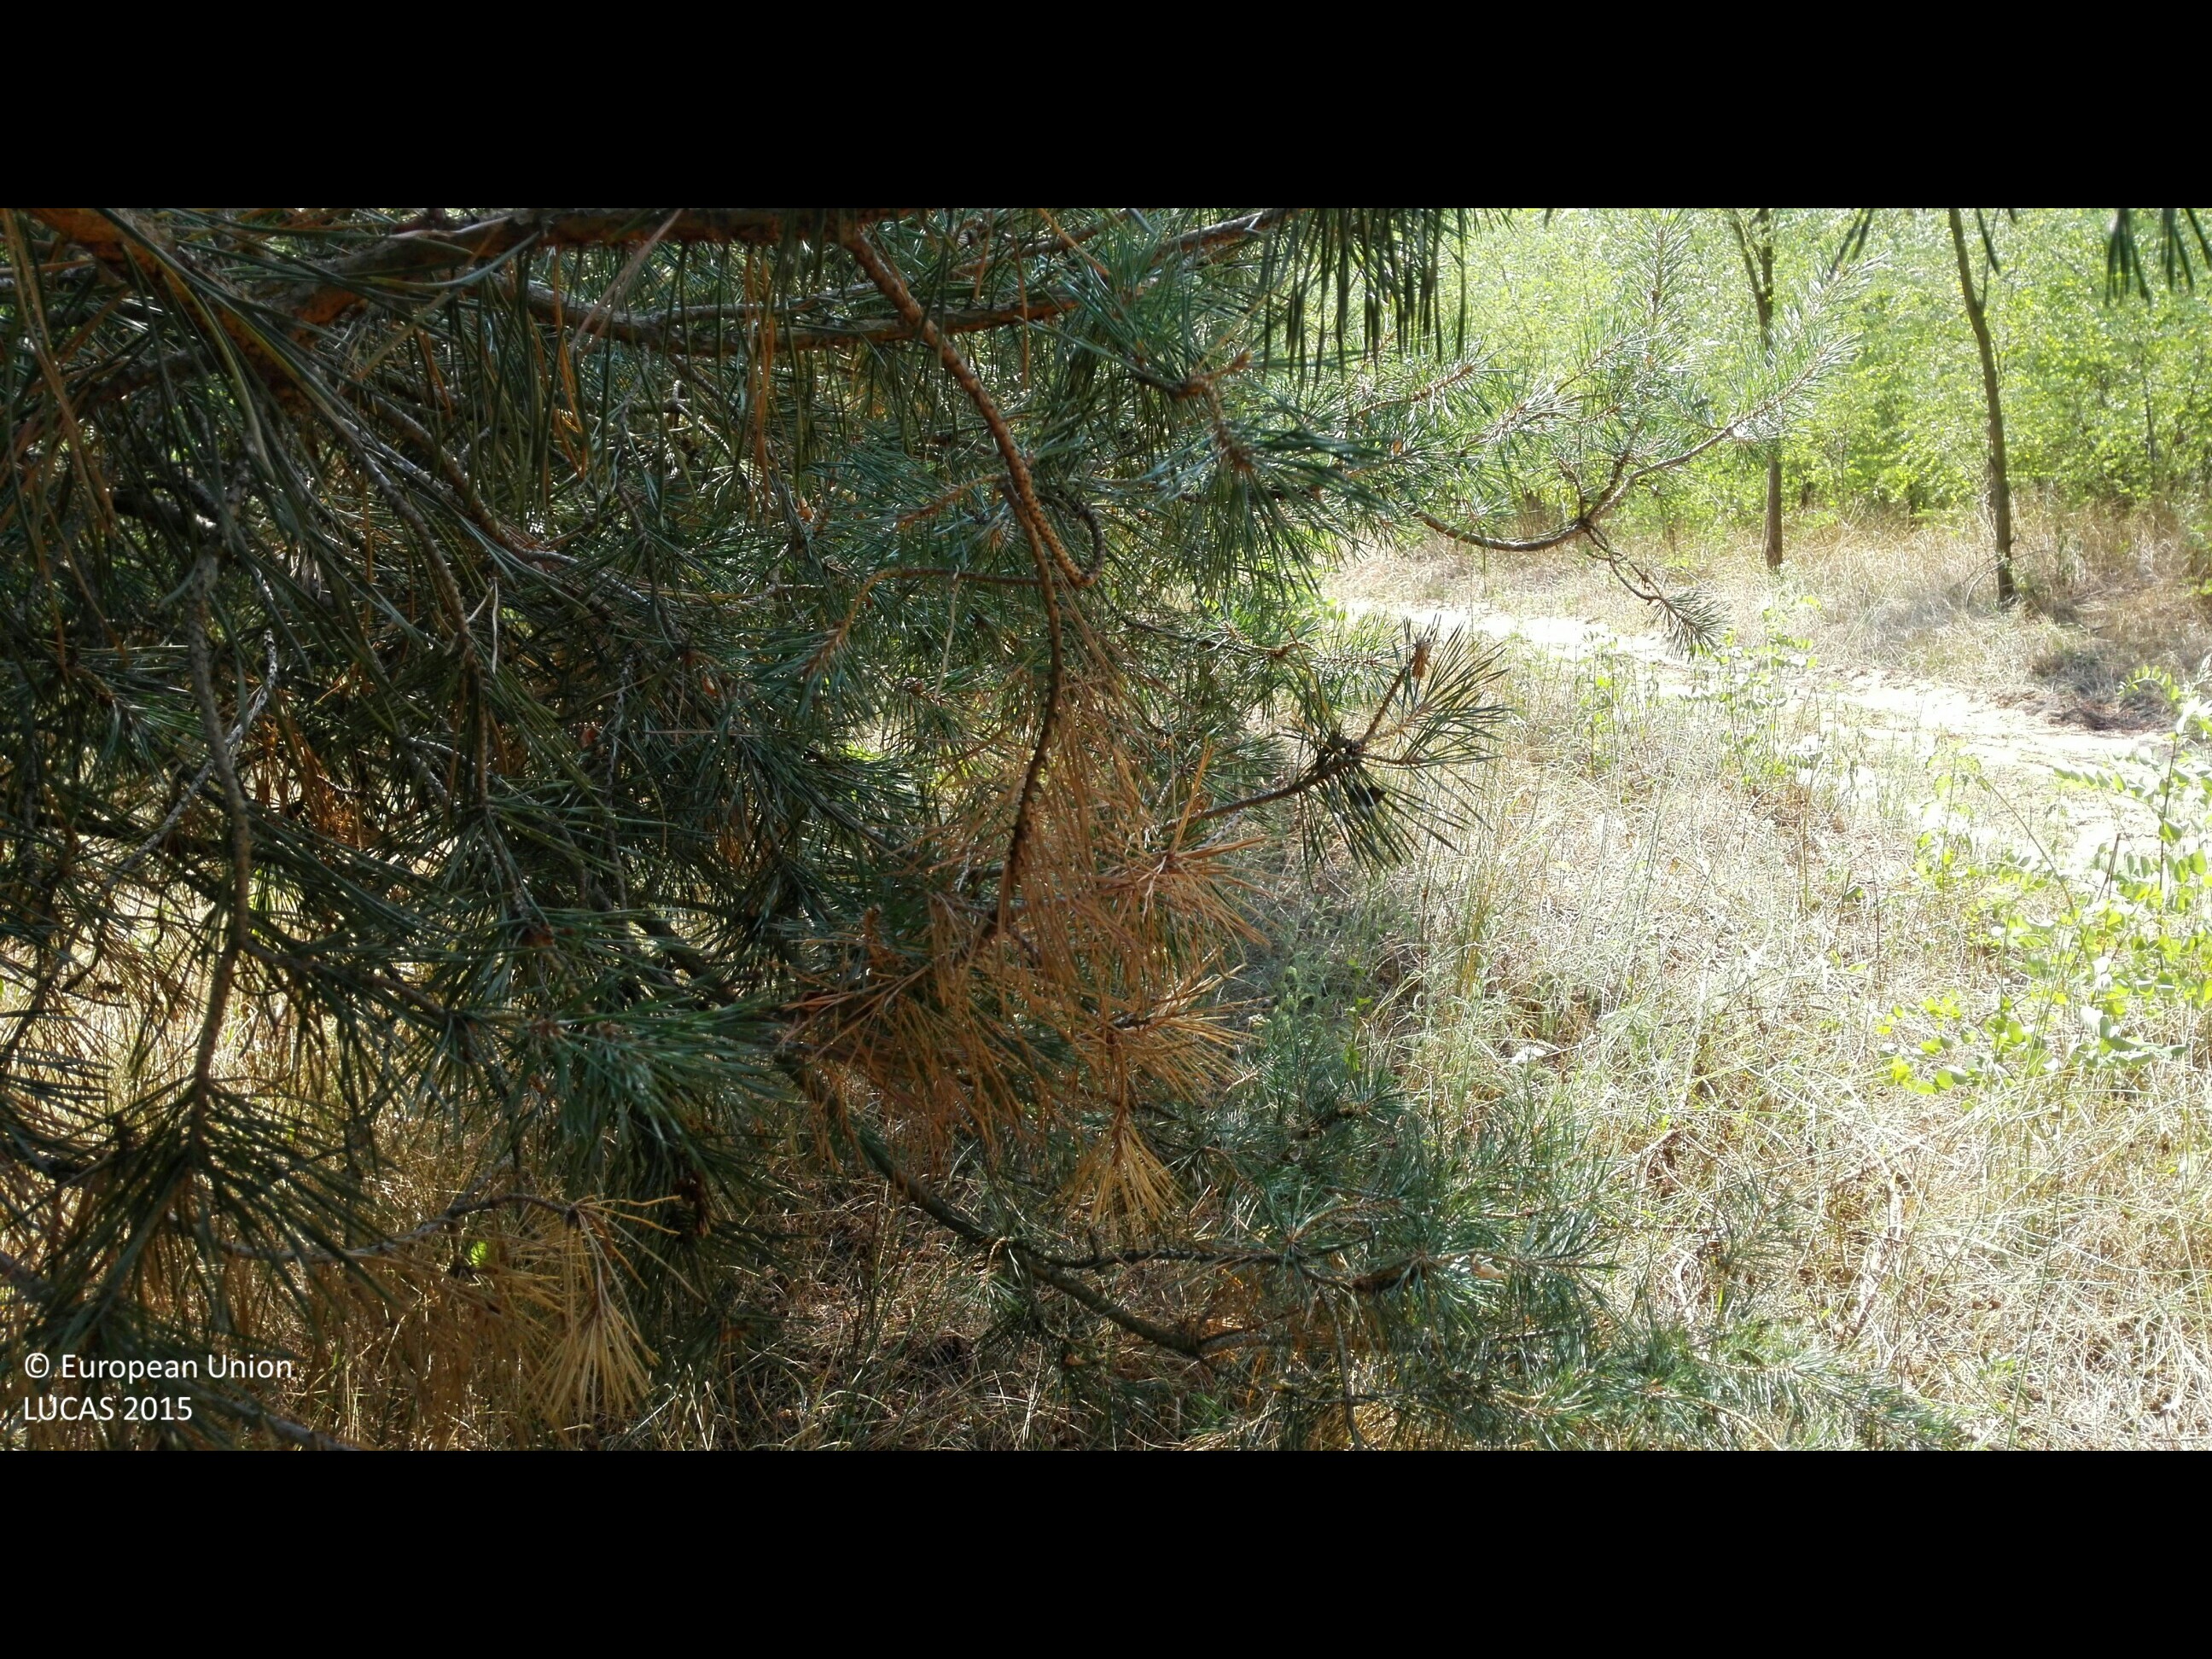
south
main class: Woodland
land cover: Broadleaved woodland
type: exotic forest
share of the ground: > 75 %
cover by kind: broadleaved forest trees 85 %, coniferous forest trees 10 %, herbaceous plants 5 %
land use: Forestry
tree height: > 5 m
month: August
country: HU
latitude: 47.5950
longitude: 22.0601
